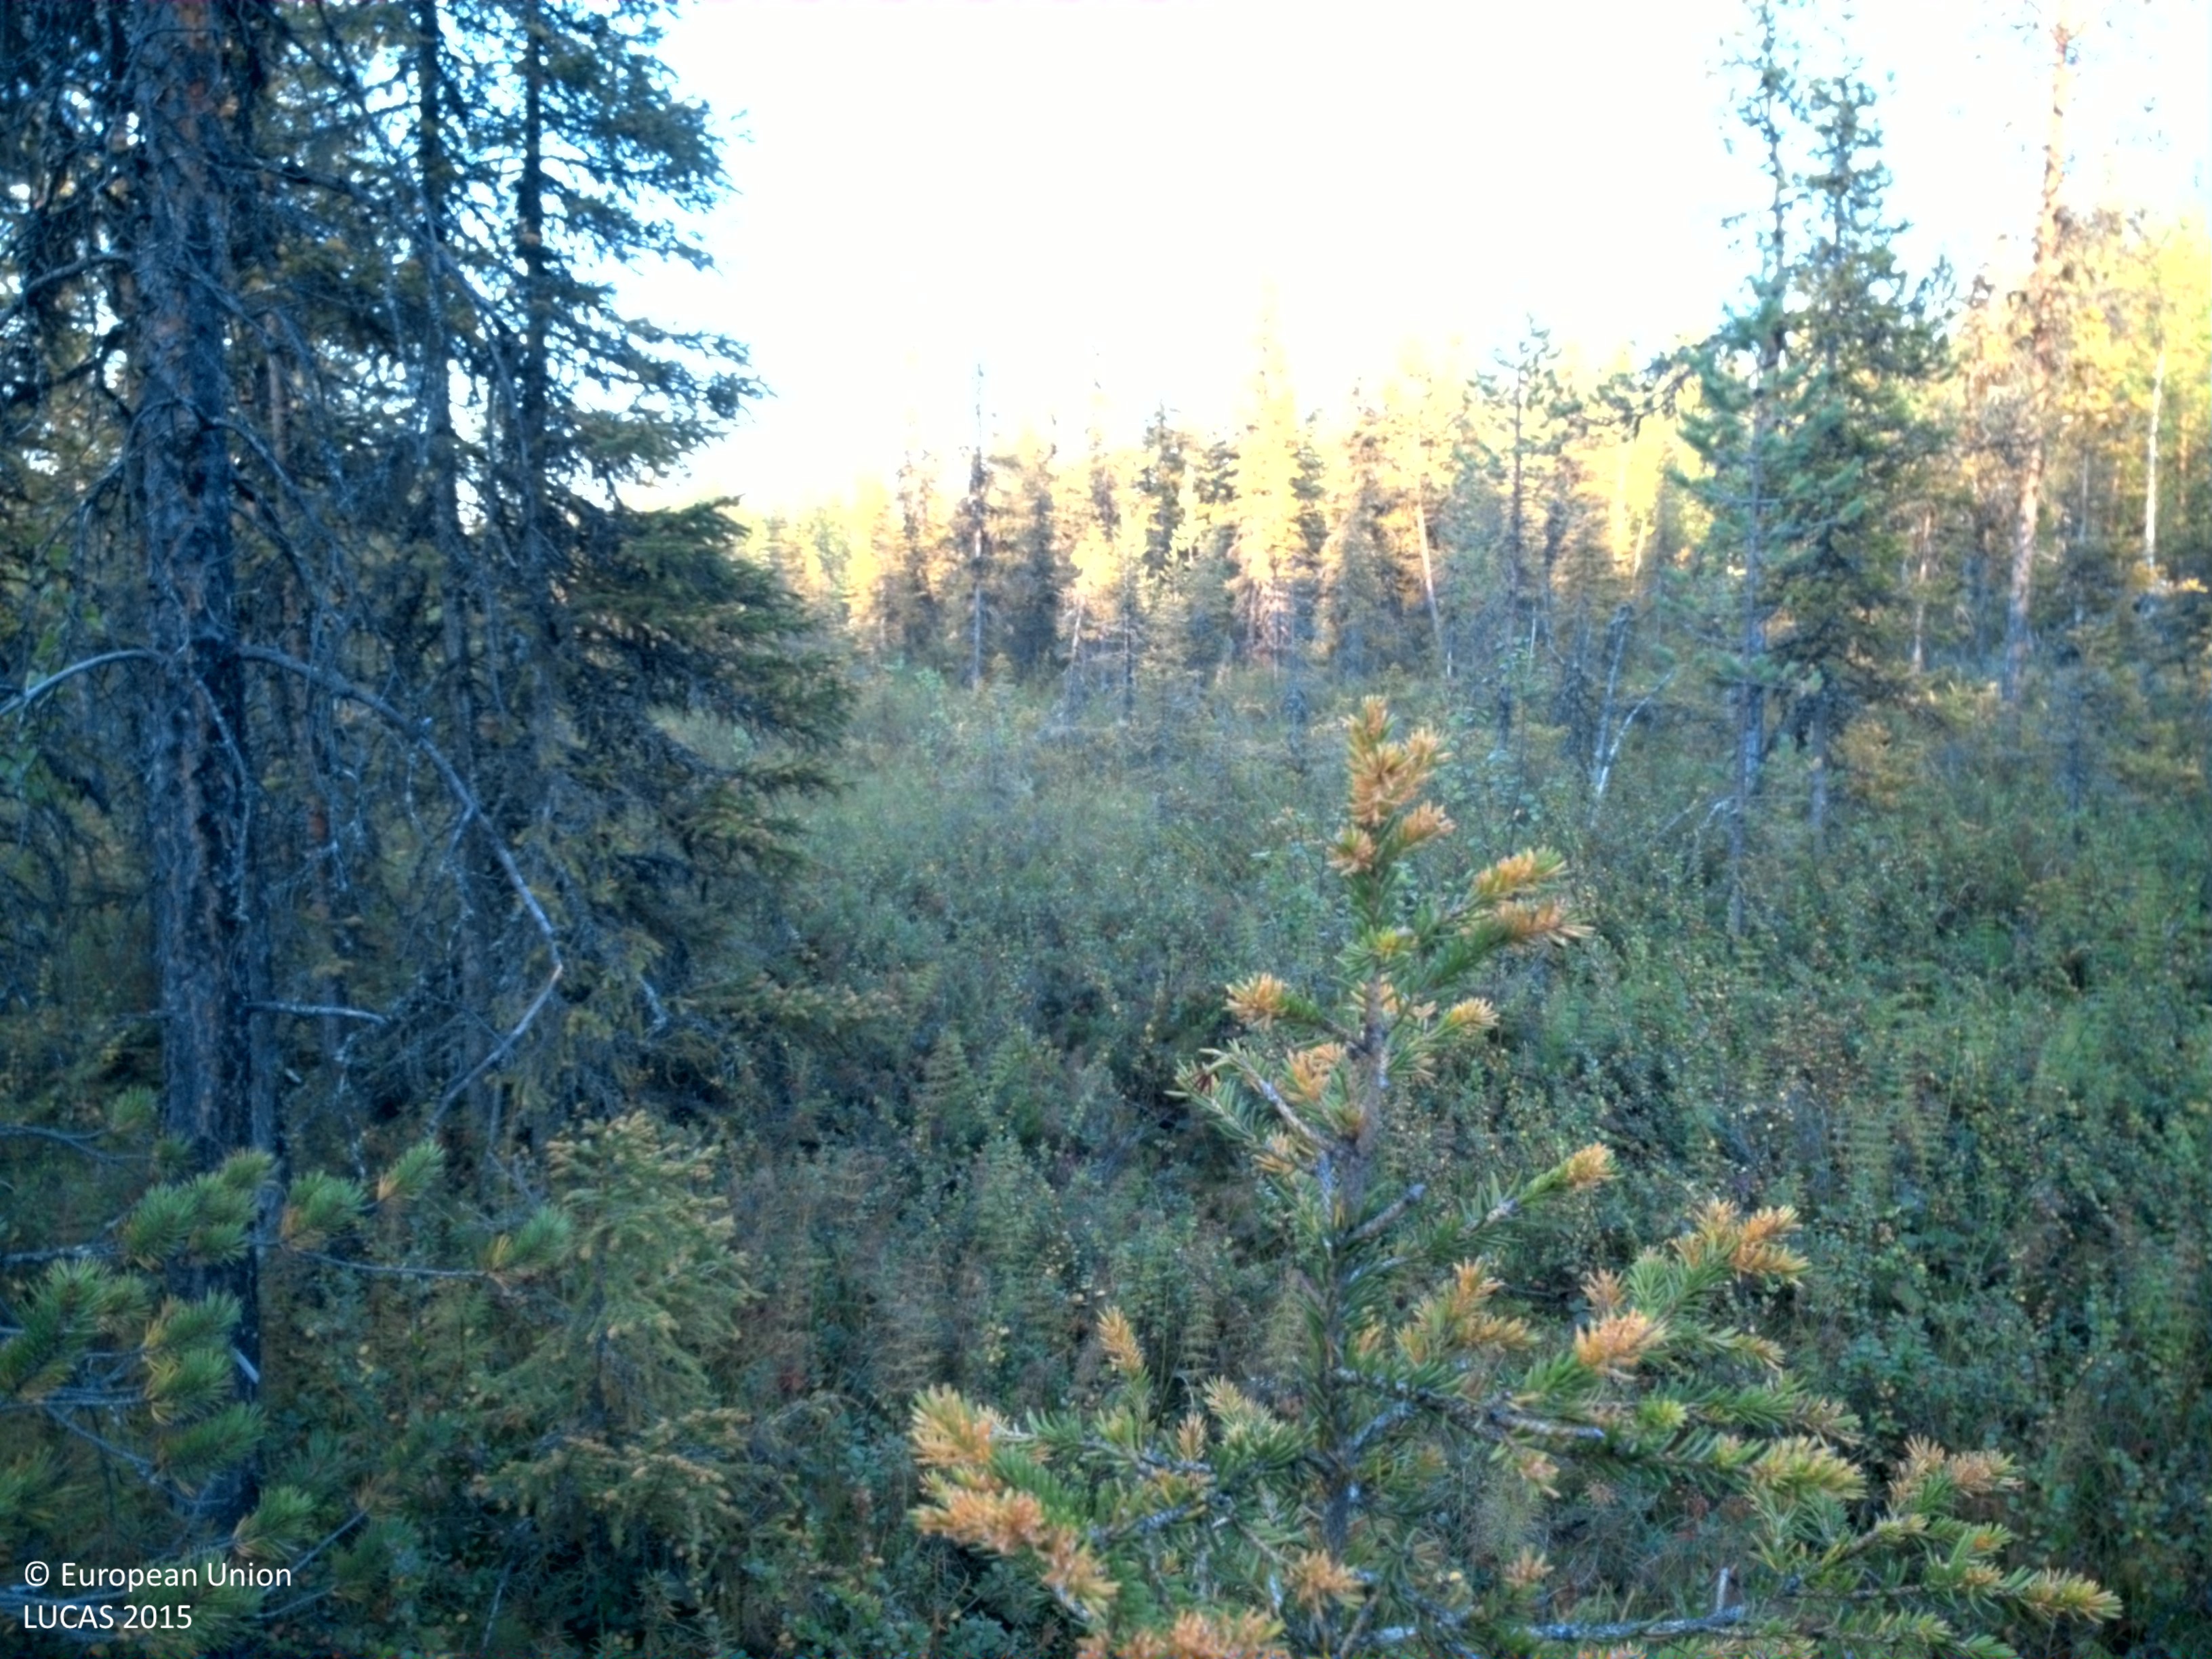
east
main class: Woodland
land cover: Spruce dominated coniferous woodland
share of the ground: 25 - 50 %
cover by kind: shrubs 70 %, coniferous forest trees 30 %
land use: Forestry
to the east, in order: Spruce dominated coniferous woodland; Shrubland with sparse tree cover; Spruce dominated coniferous woodland; Spruce dominated mixed woodland; Spruce dominated coniferous woodland; Peatbogs; Other coniferous woodland
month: August
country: SE
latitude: 66.7285
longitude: 19.9996
